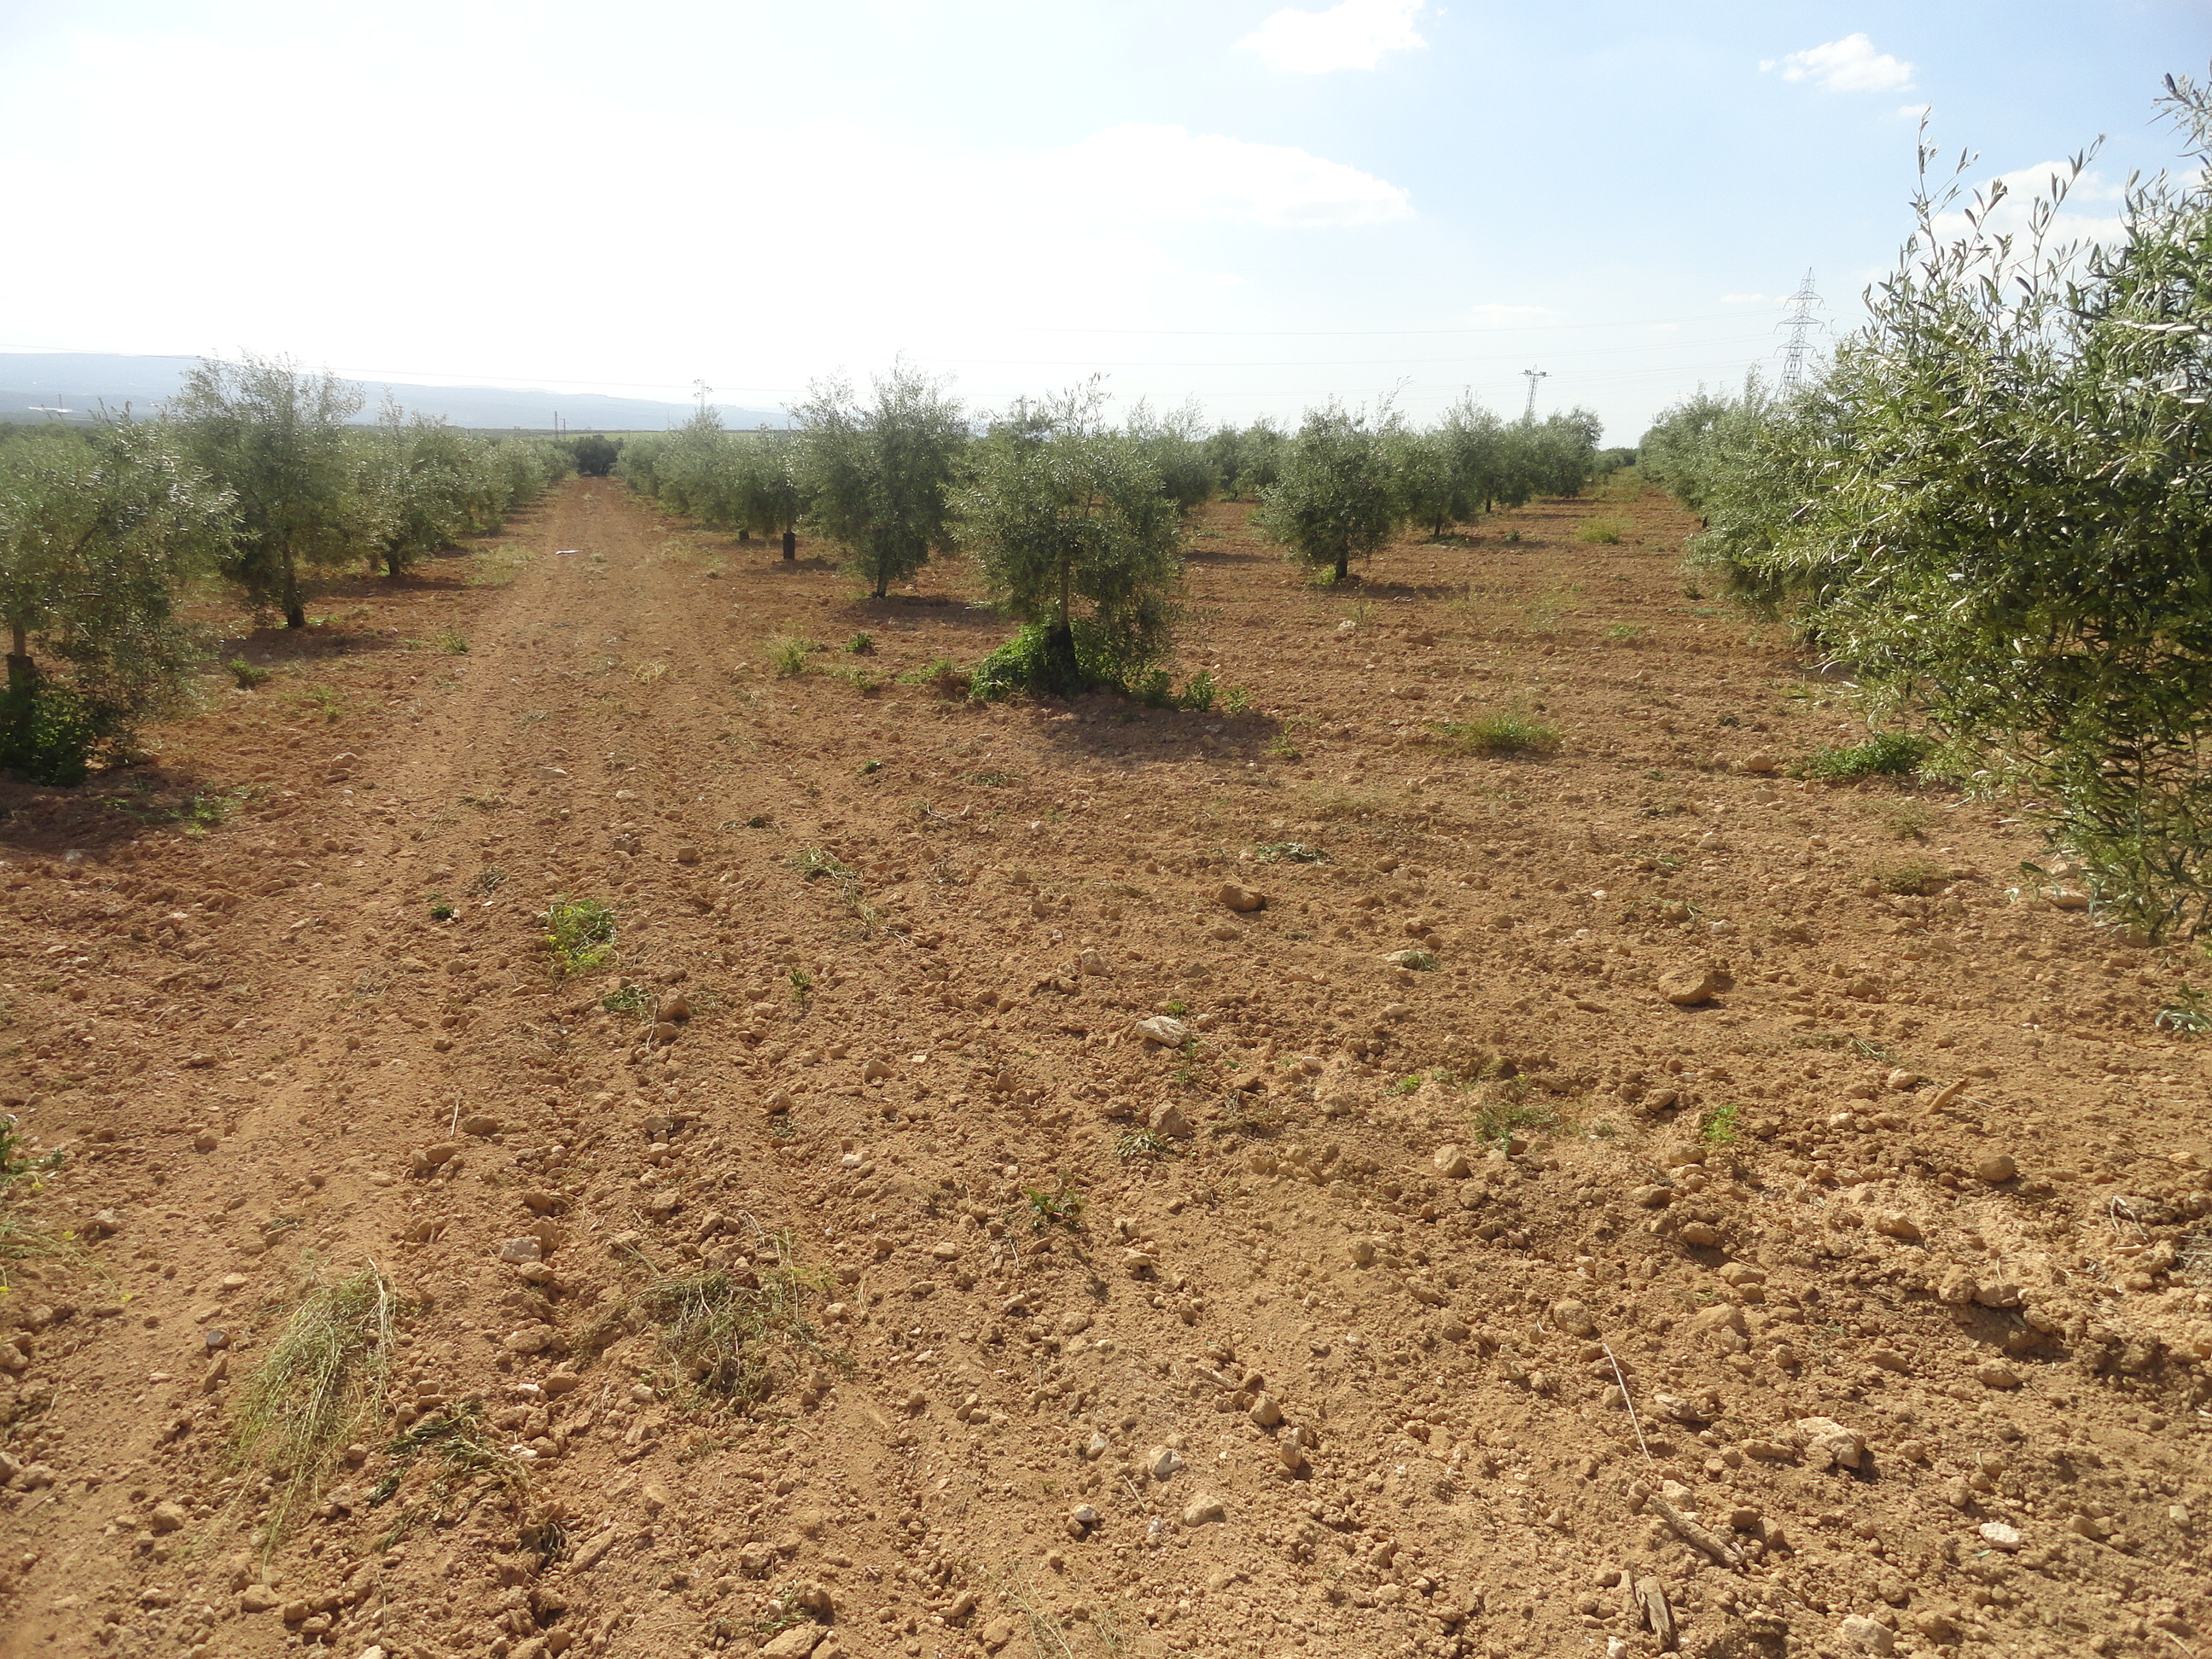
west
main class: Cropland
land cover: Olive groves
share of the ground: 10 - 25 %
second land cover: Other bare soil
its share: > 75 %
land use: Agriculture (excluding fallow land and kitchen gardens)
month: April
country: ES
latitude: 37.5272
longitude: -4.5230
